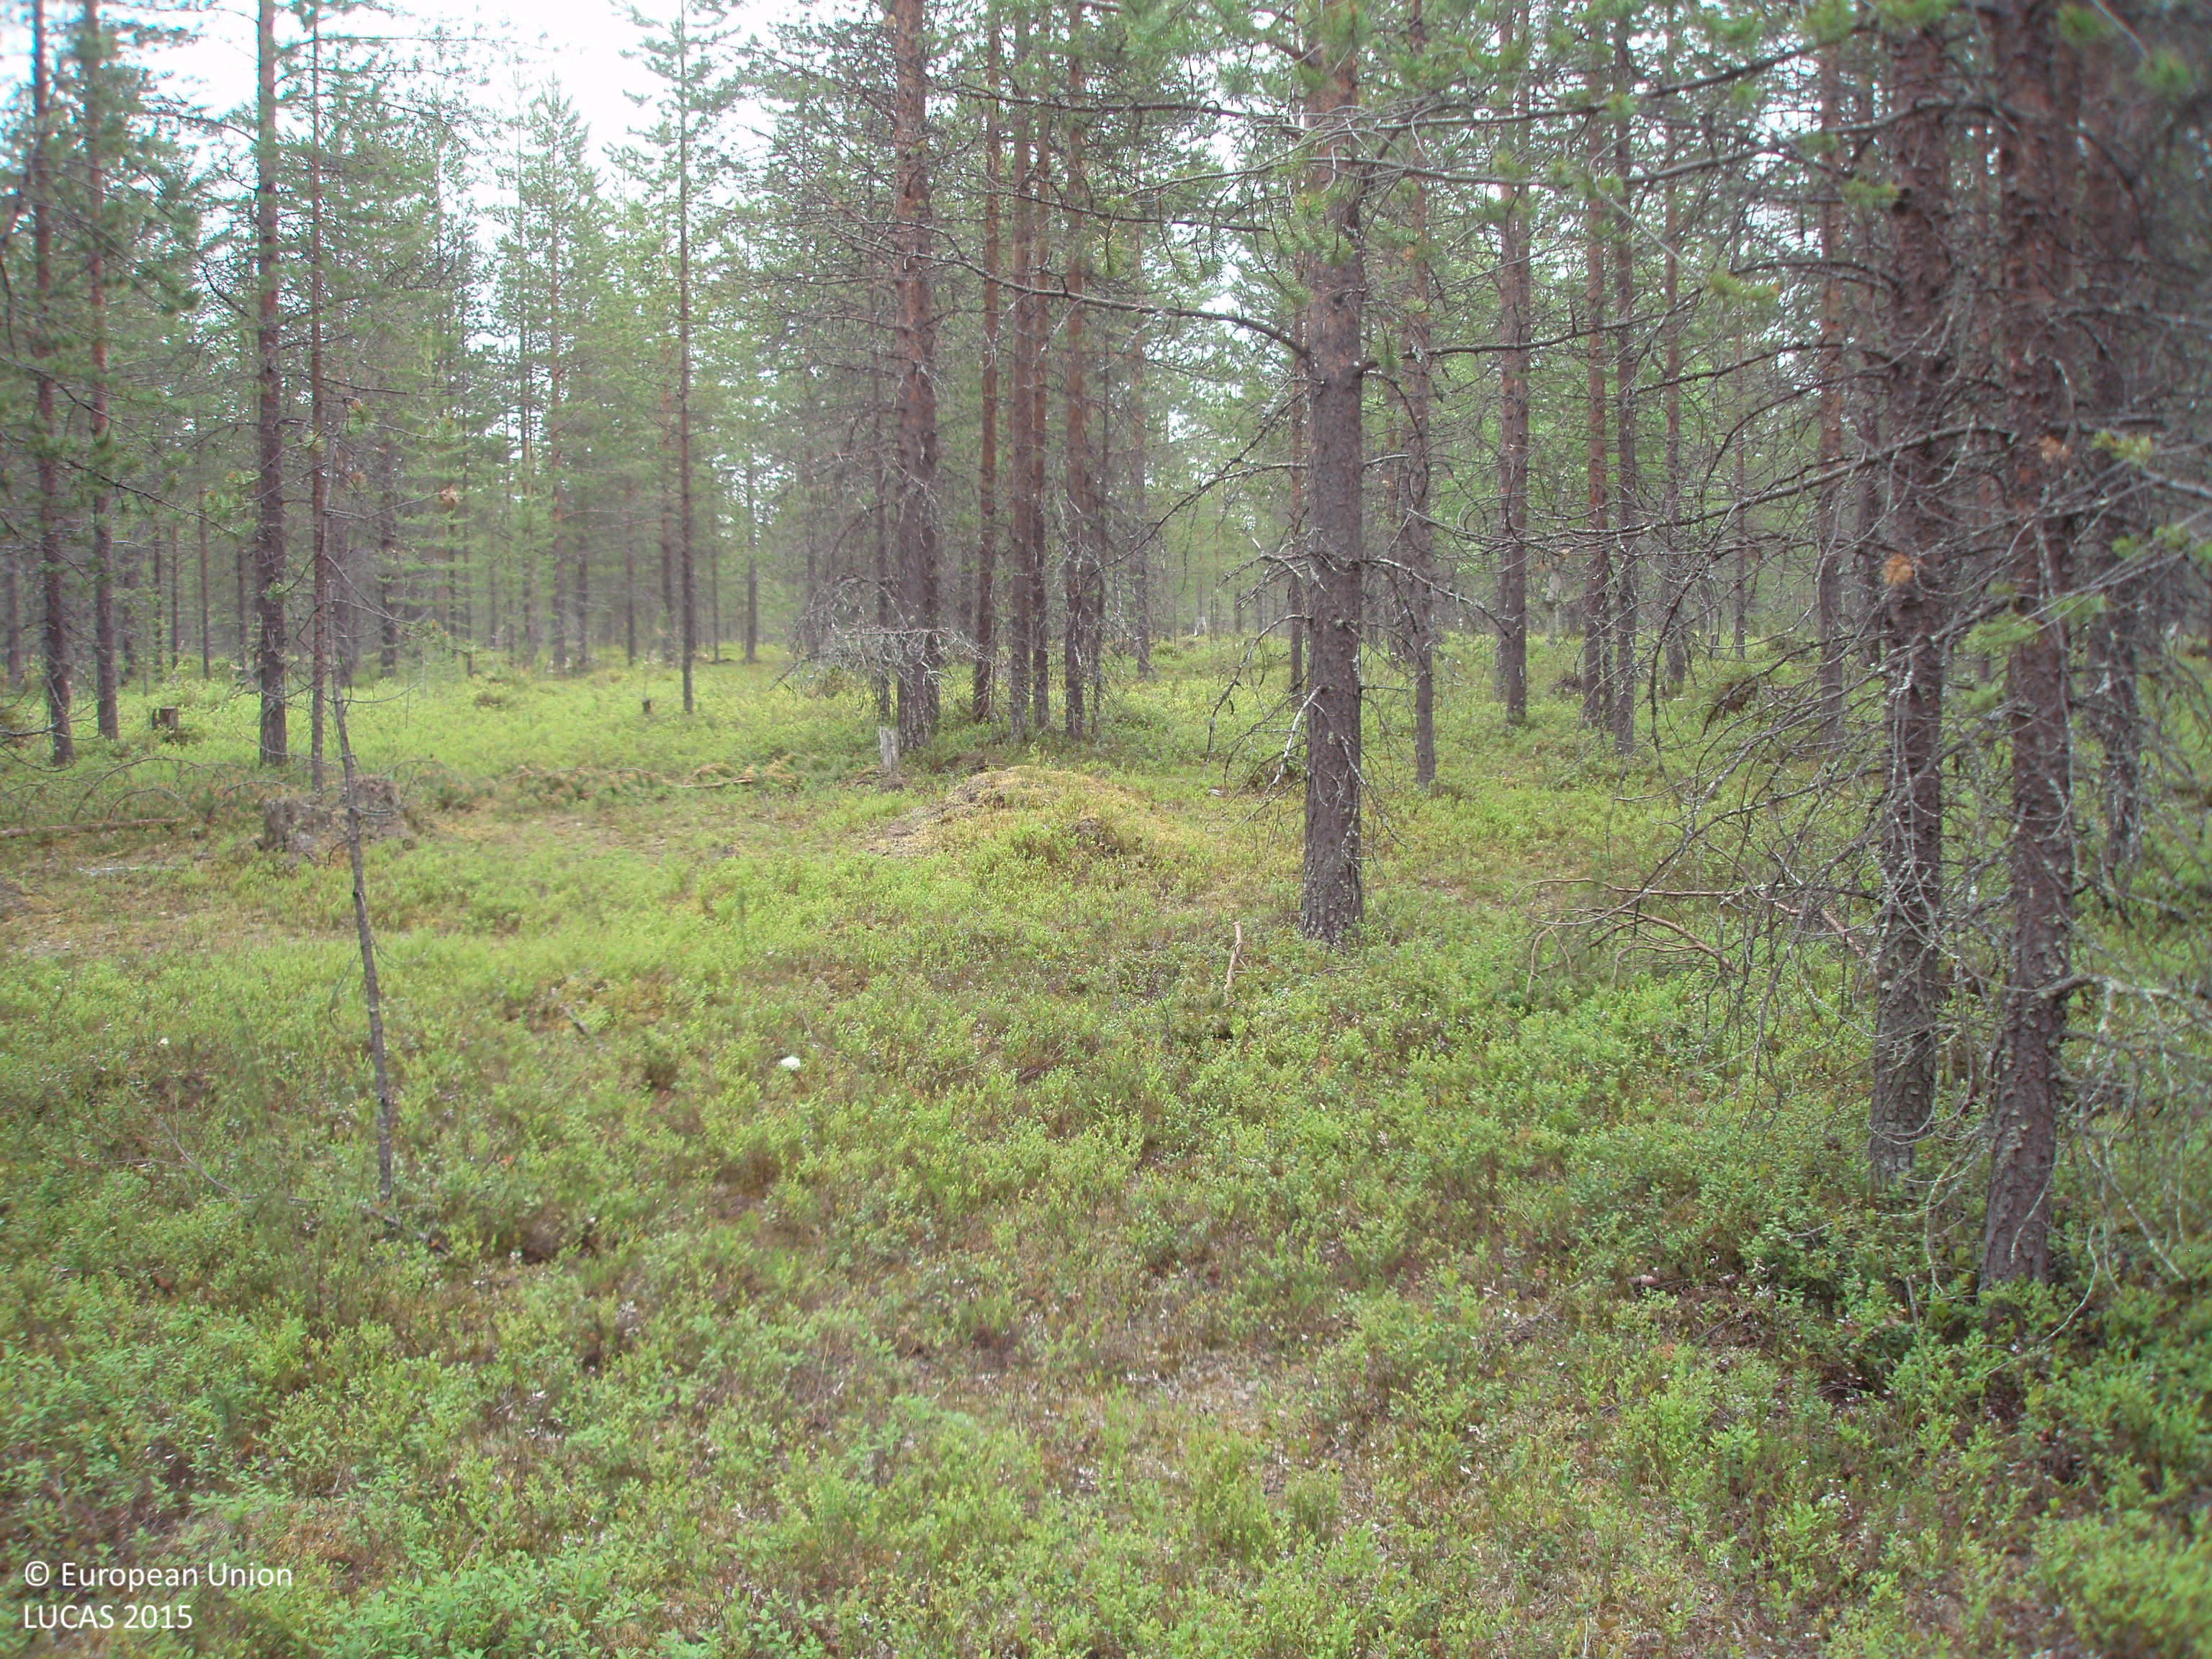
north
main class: Woodland
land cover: Pine dominated coniferous woodland
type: boreal forest
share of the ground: > 75 %
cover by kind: coniferous forest trees 80 %, shrubs 20 %
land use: Forestry
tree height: > 5 m
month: July
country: FI
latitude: 67.7029
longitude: 28.7687
